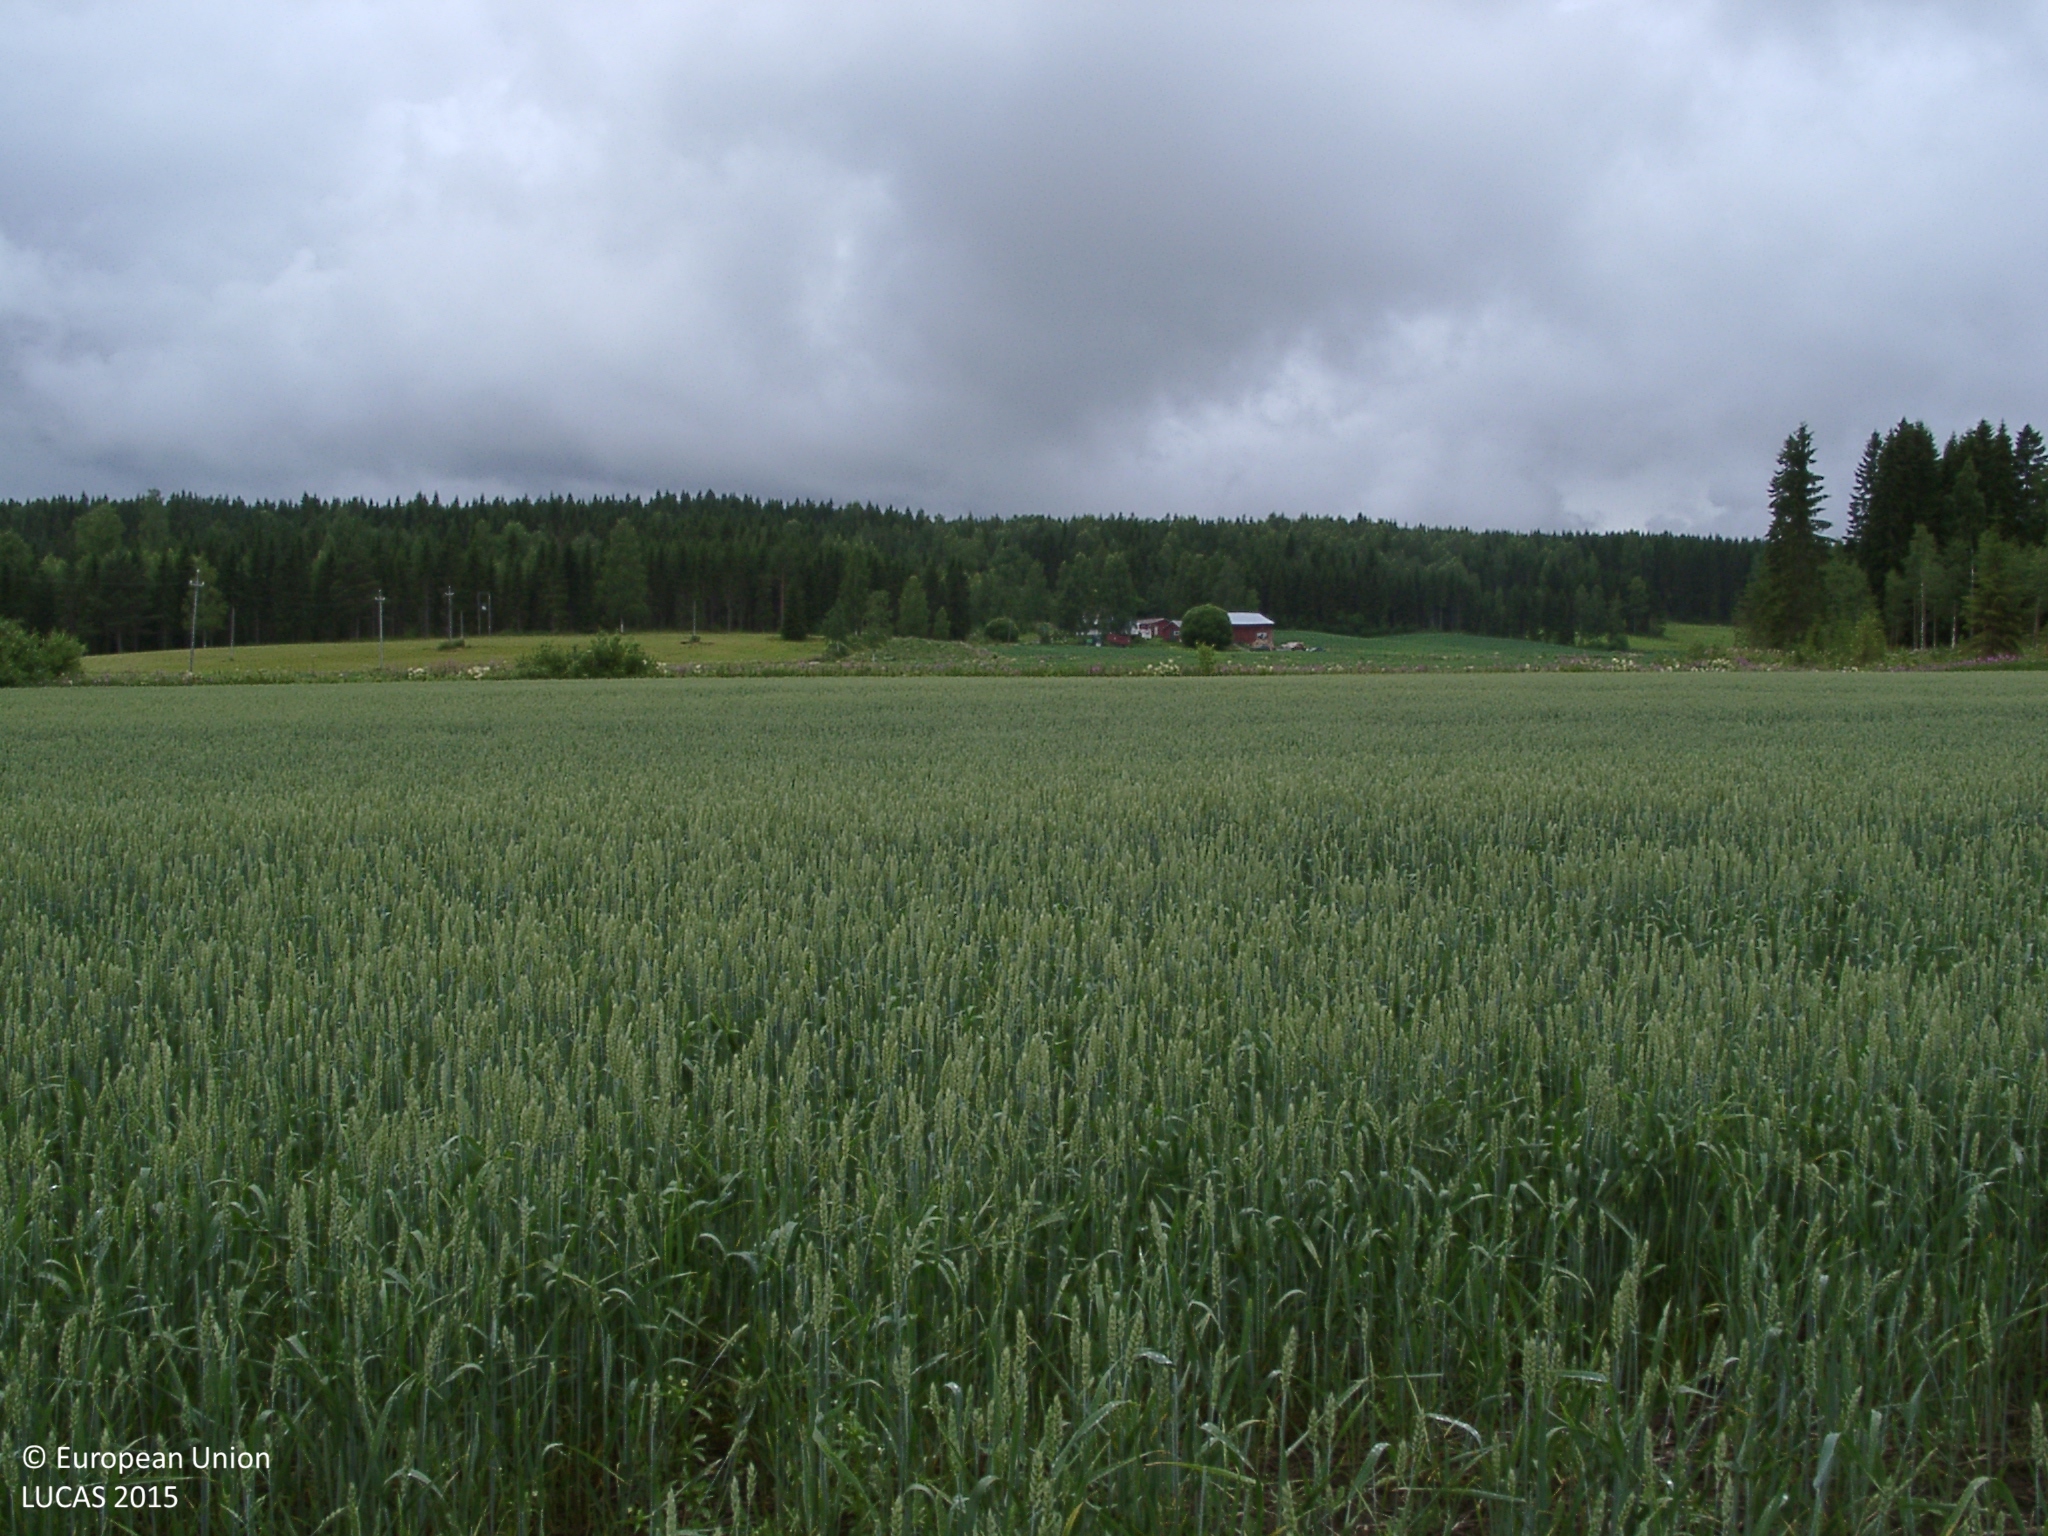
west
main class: Cropland
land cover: Common wheat
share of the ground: > 75 %
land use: Agriculture (excluding fallow land and kitchen gardens)
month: July
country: FI
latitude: 61.9654
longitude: 25.3520
